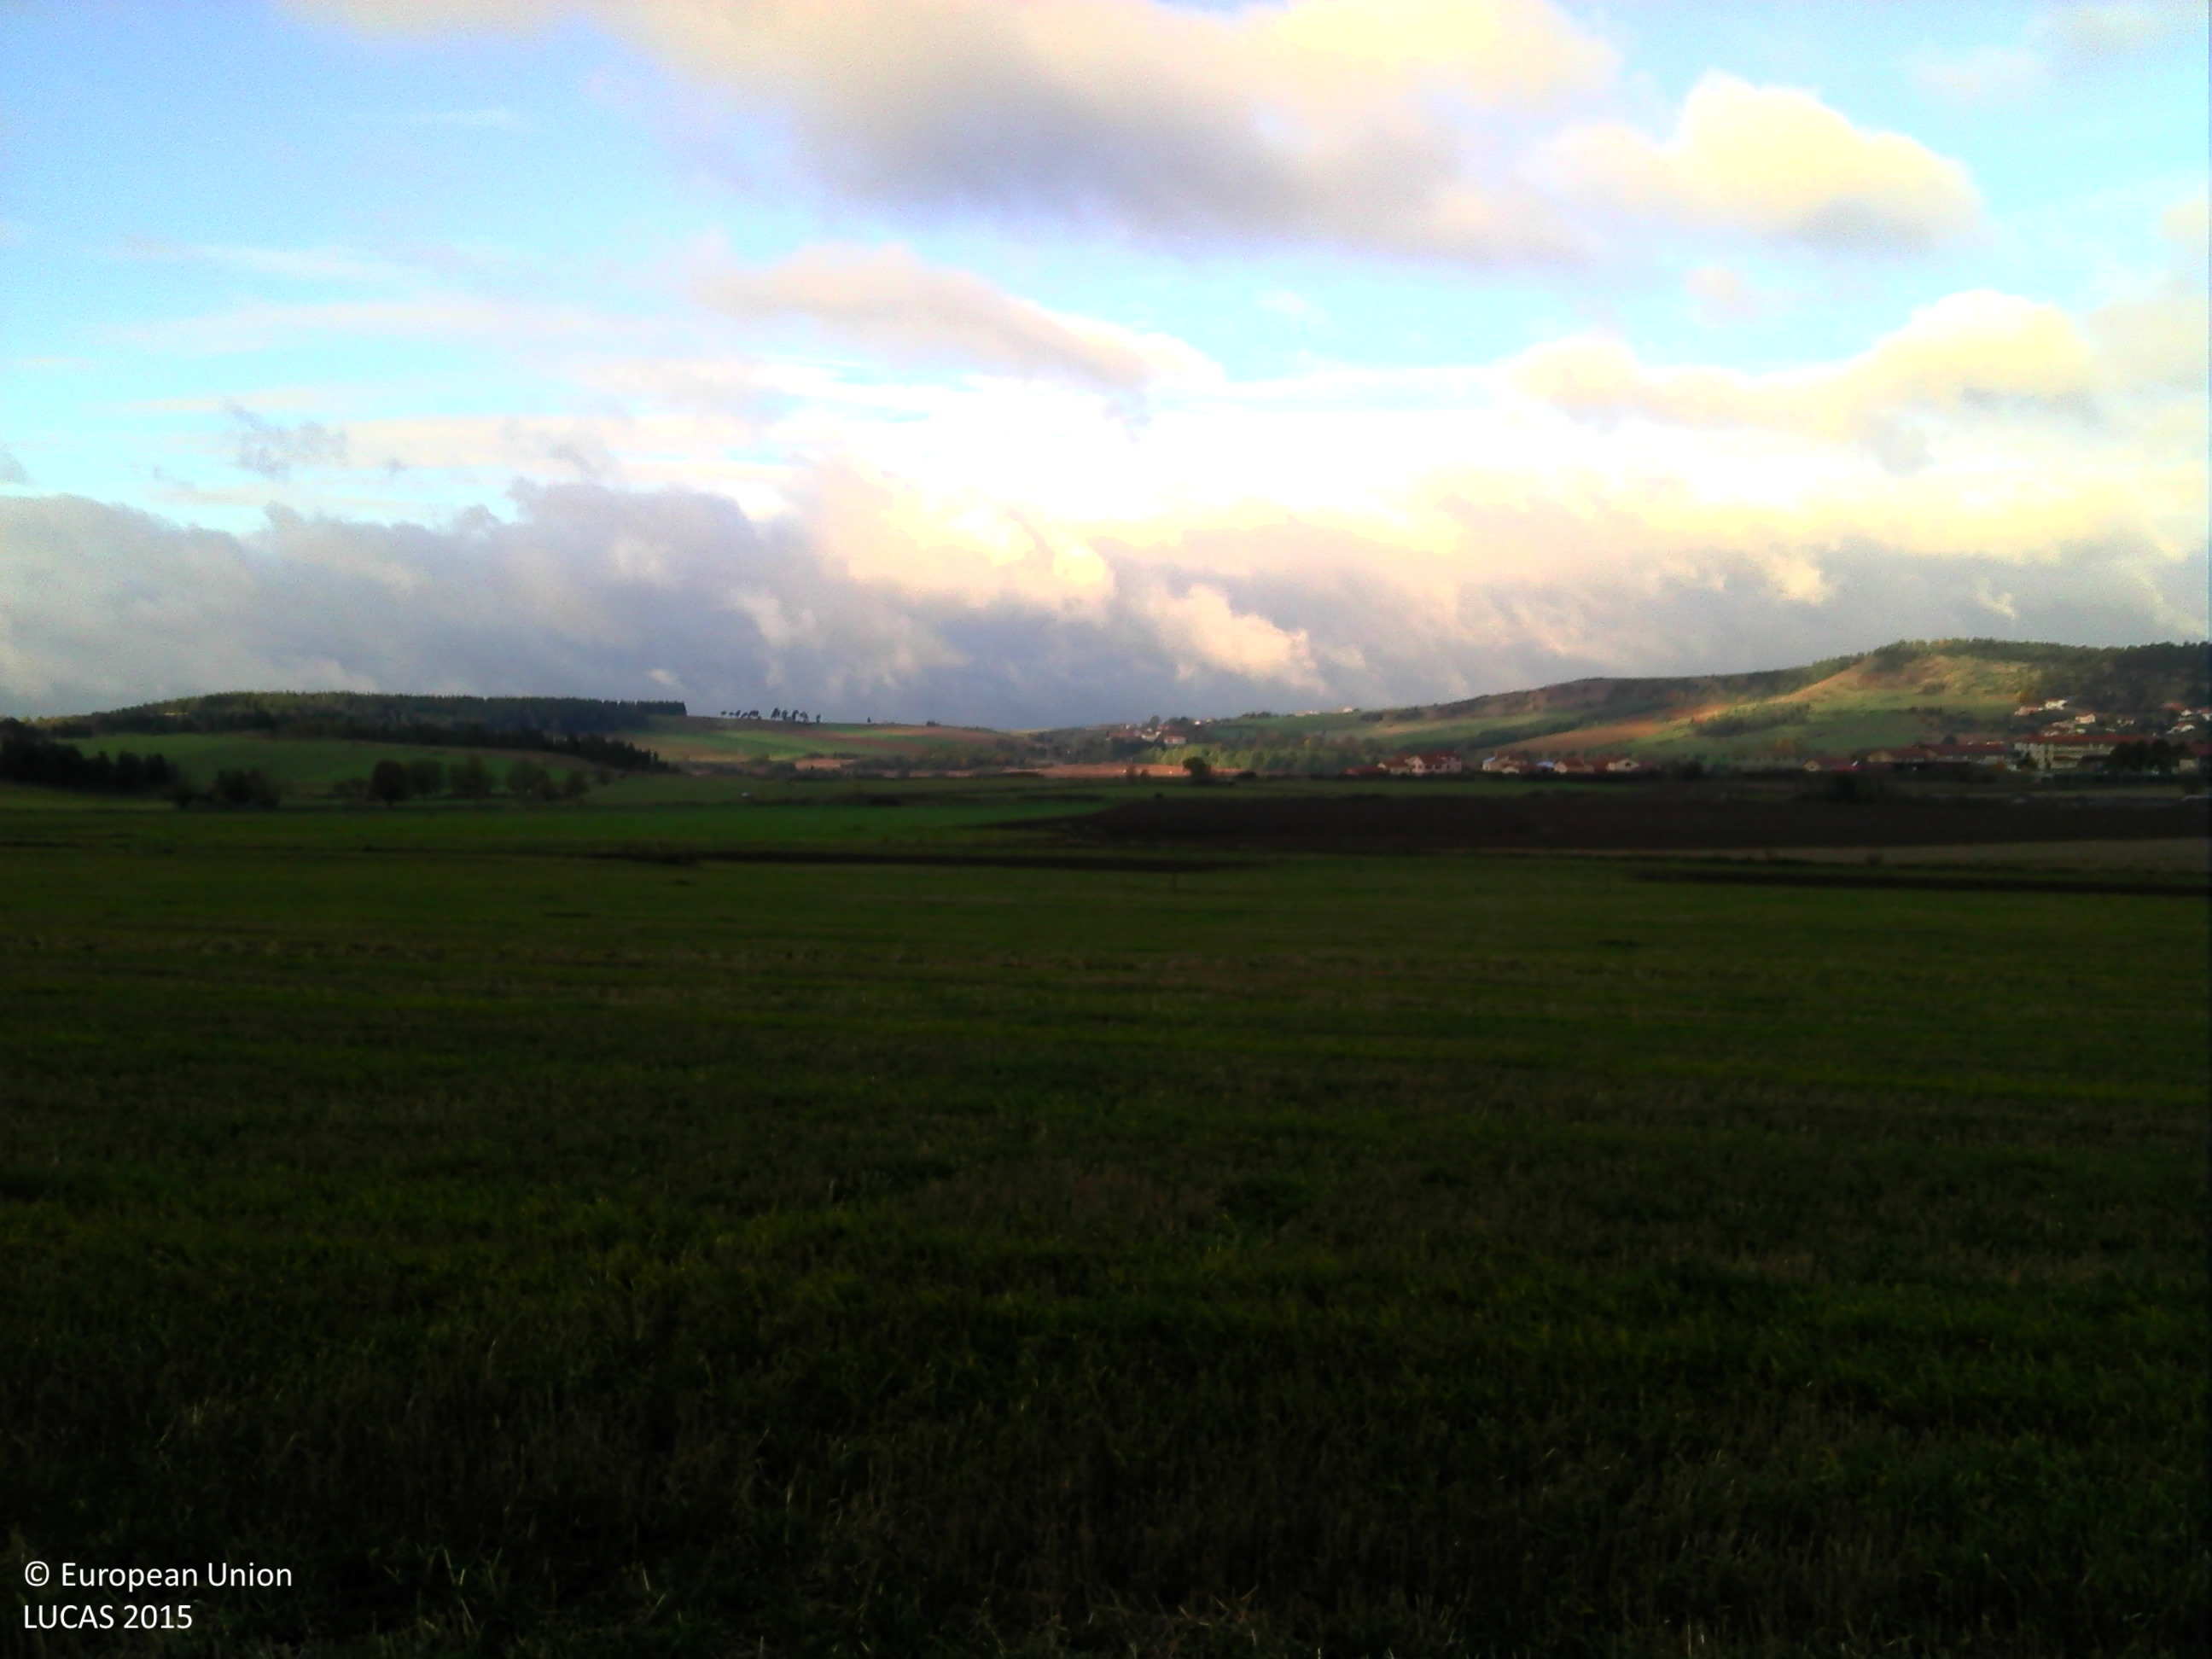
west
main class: Cropland
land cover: Common wheat
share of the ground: 50 - 75 %
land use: Agriculture (excluding fallow land and kitchen gardens)
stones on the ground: < 10 %
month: October
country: FR
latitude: 44.8368
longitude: 3.8442
